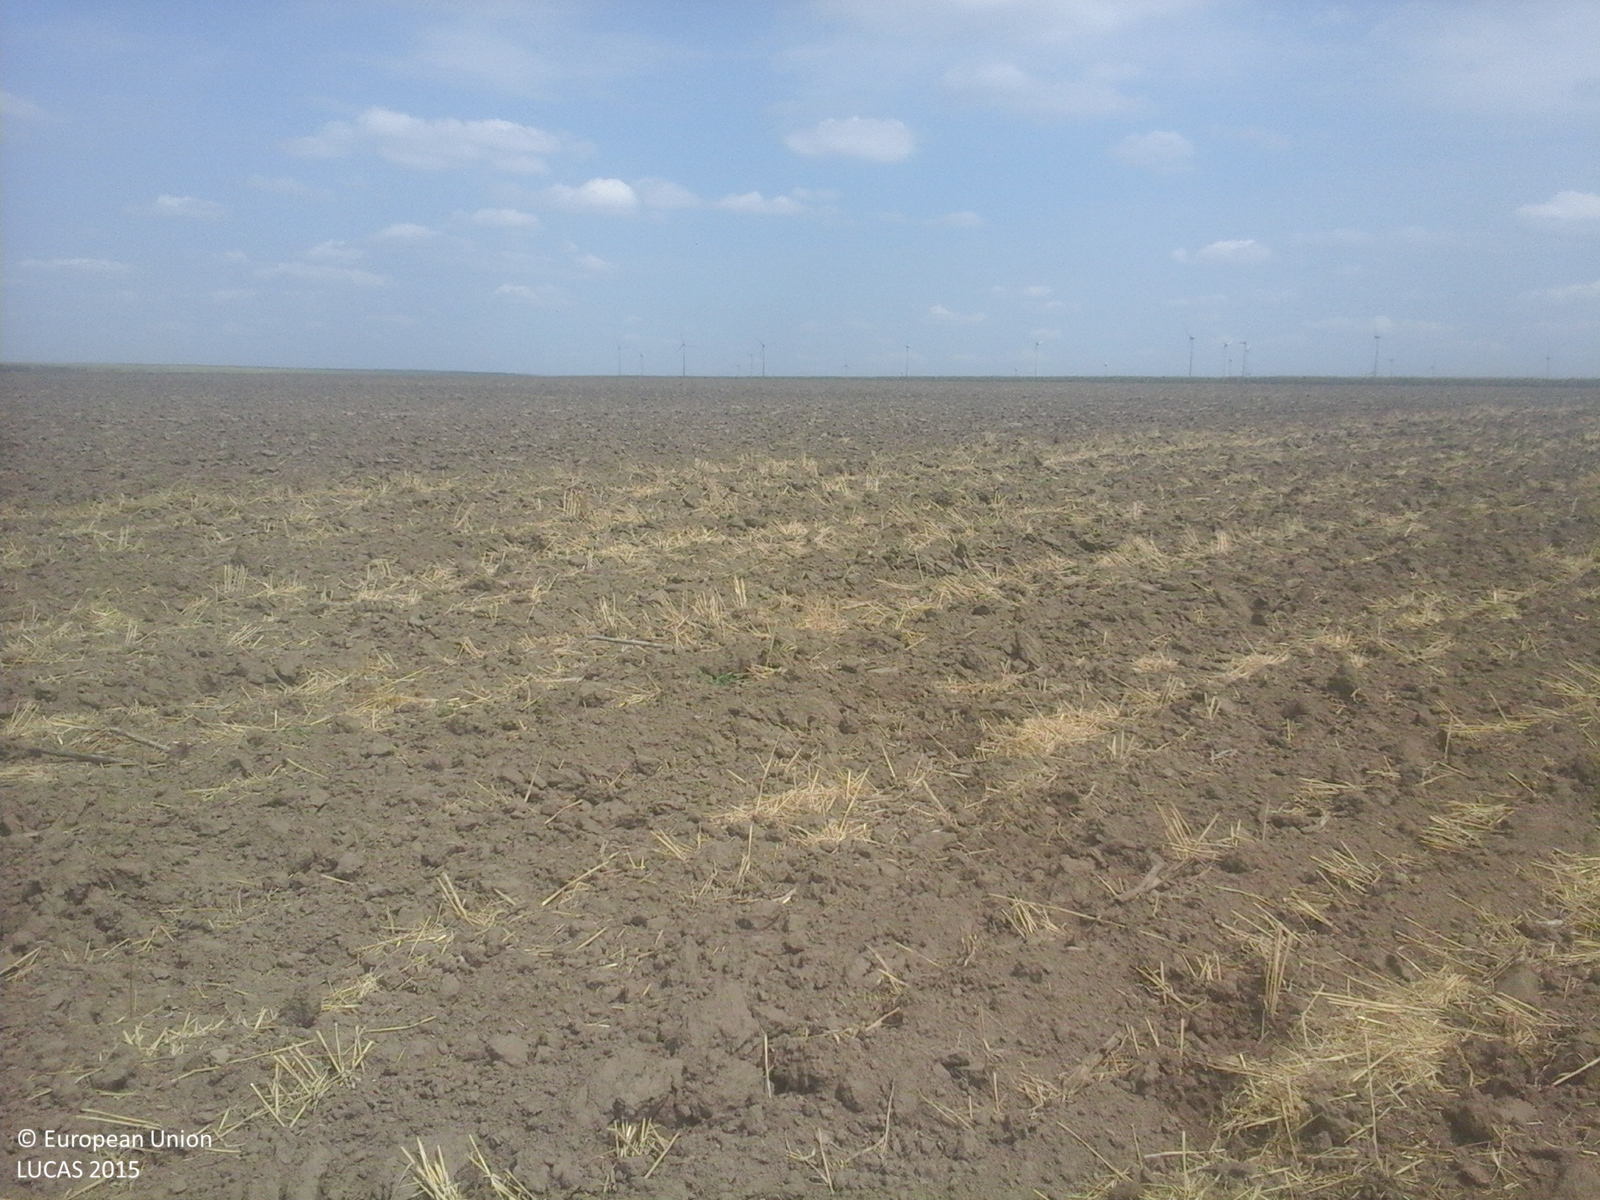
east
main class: Cropland
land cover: Common wheat
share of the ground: < 10 %
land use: Agriculture (excluding fallow land and kitchen gardens)
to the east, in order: Common wheat; Tracks; Sunflower
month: August
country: RO
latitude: 44.7030
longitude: 28.2799
